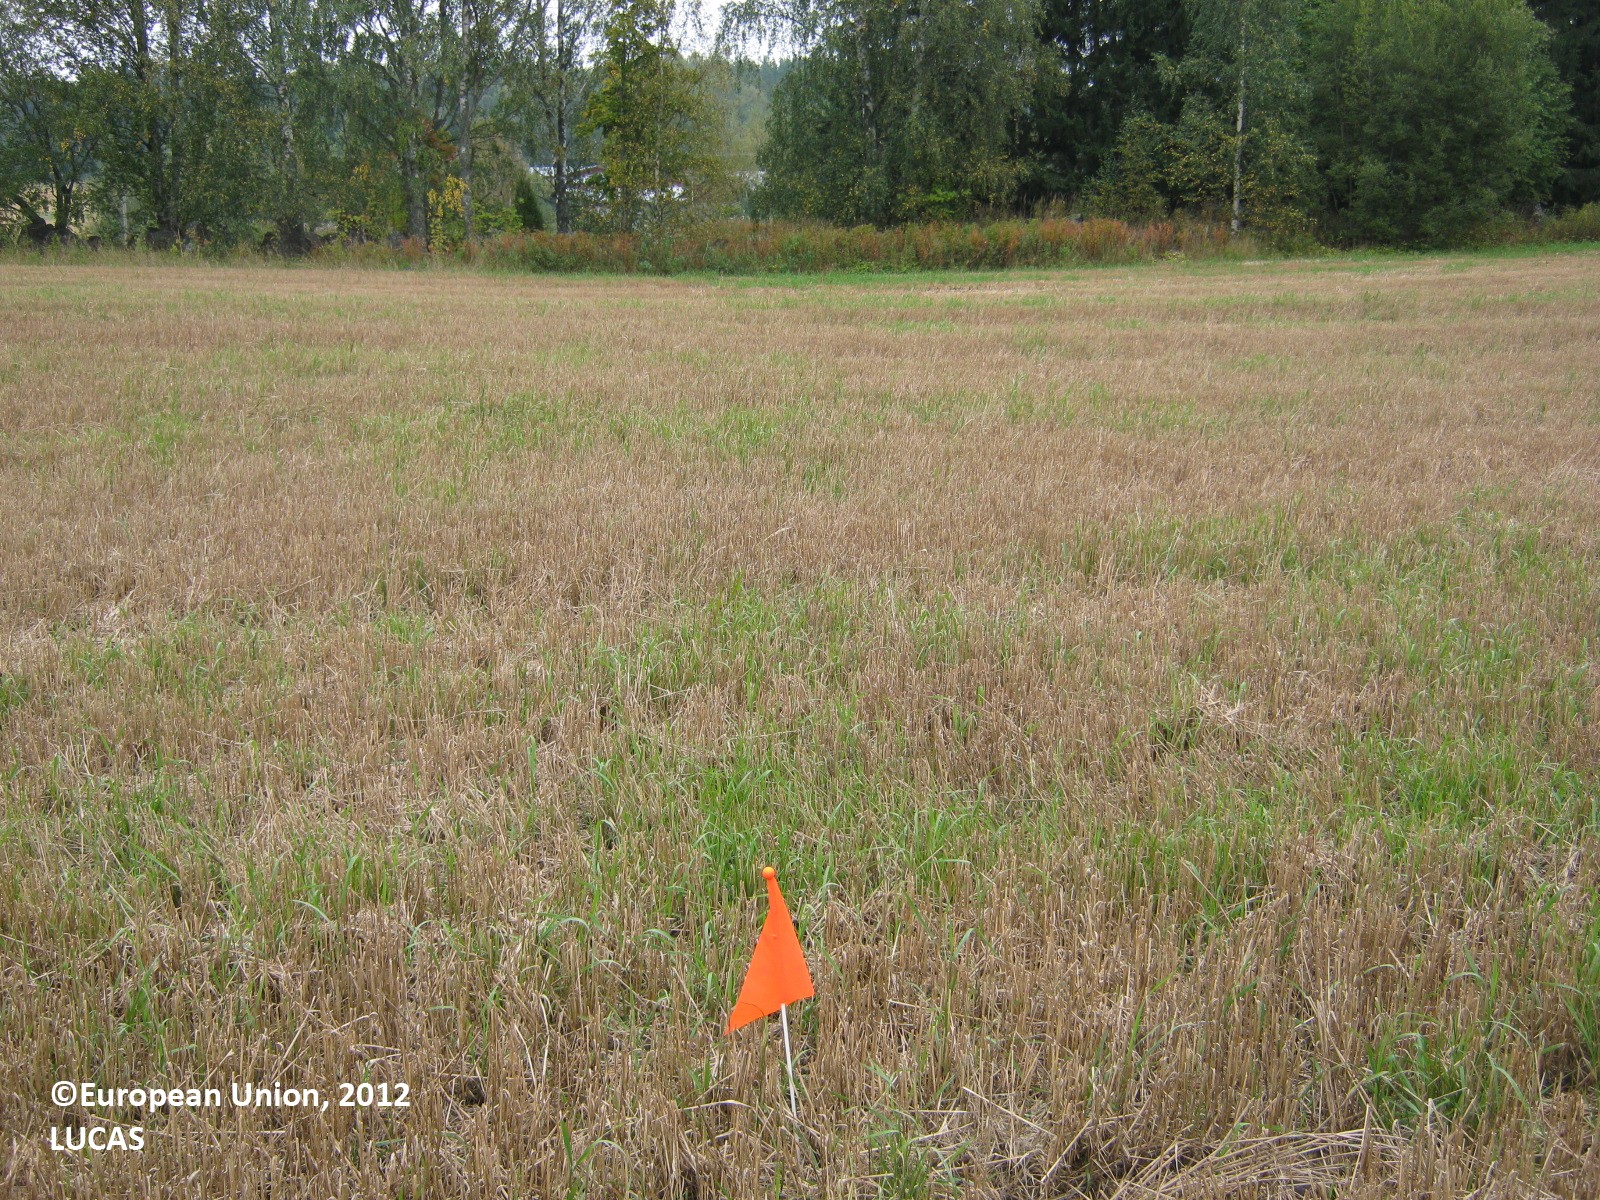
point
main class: Cropland
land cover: Barley
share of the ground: 50 - 75 %
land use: Agriculture (excluding fallow land and kitchen gardens)
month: September
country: FI
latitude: 60.5289
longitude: 27.5534
